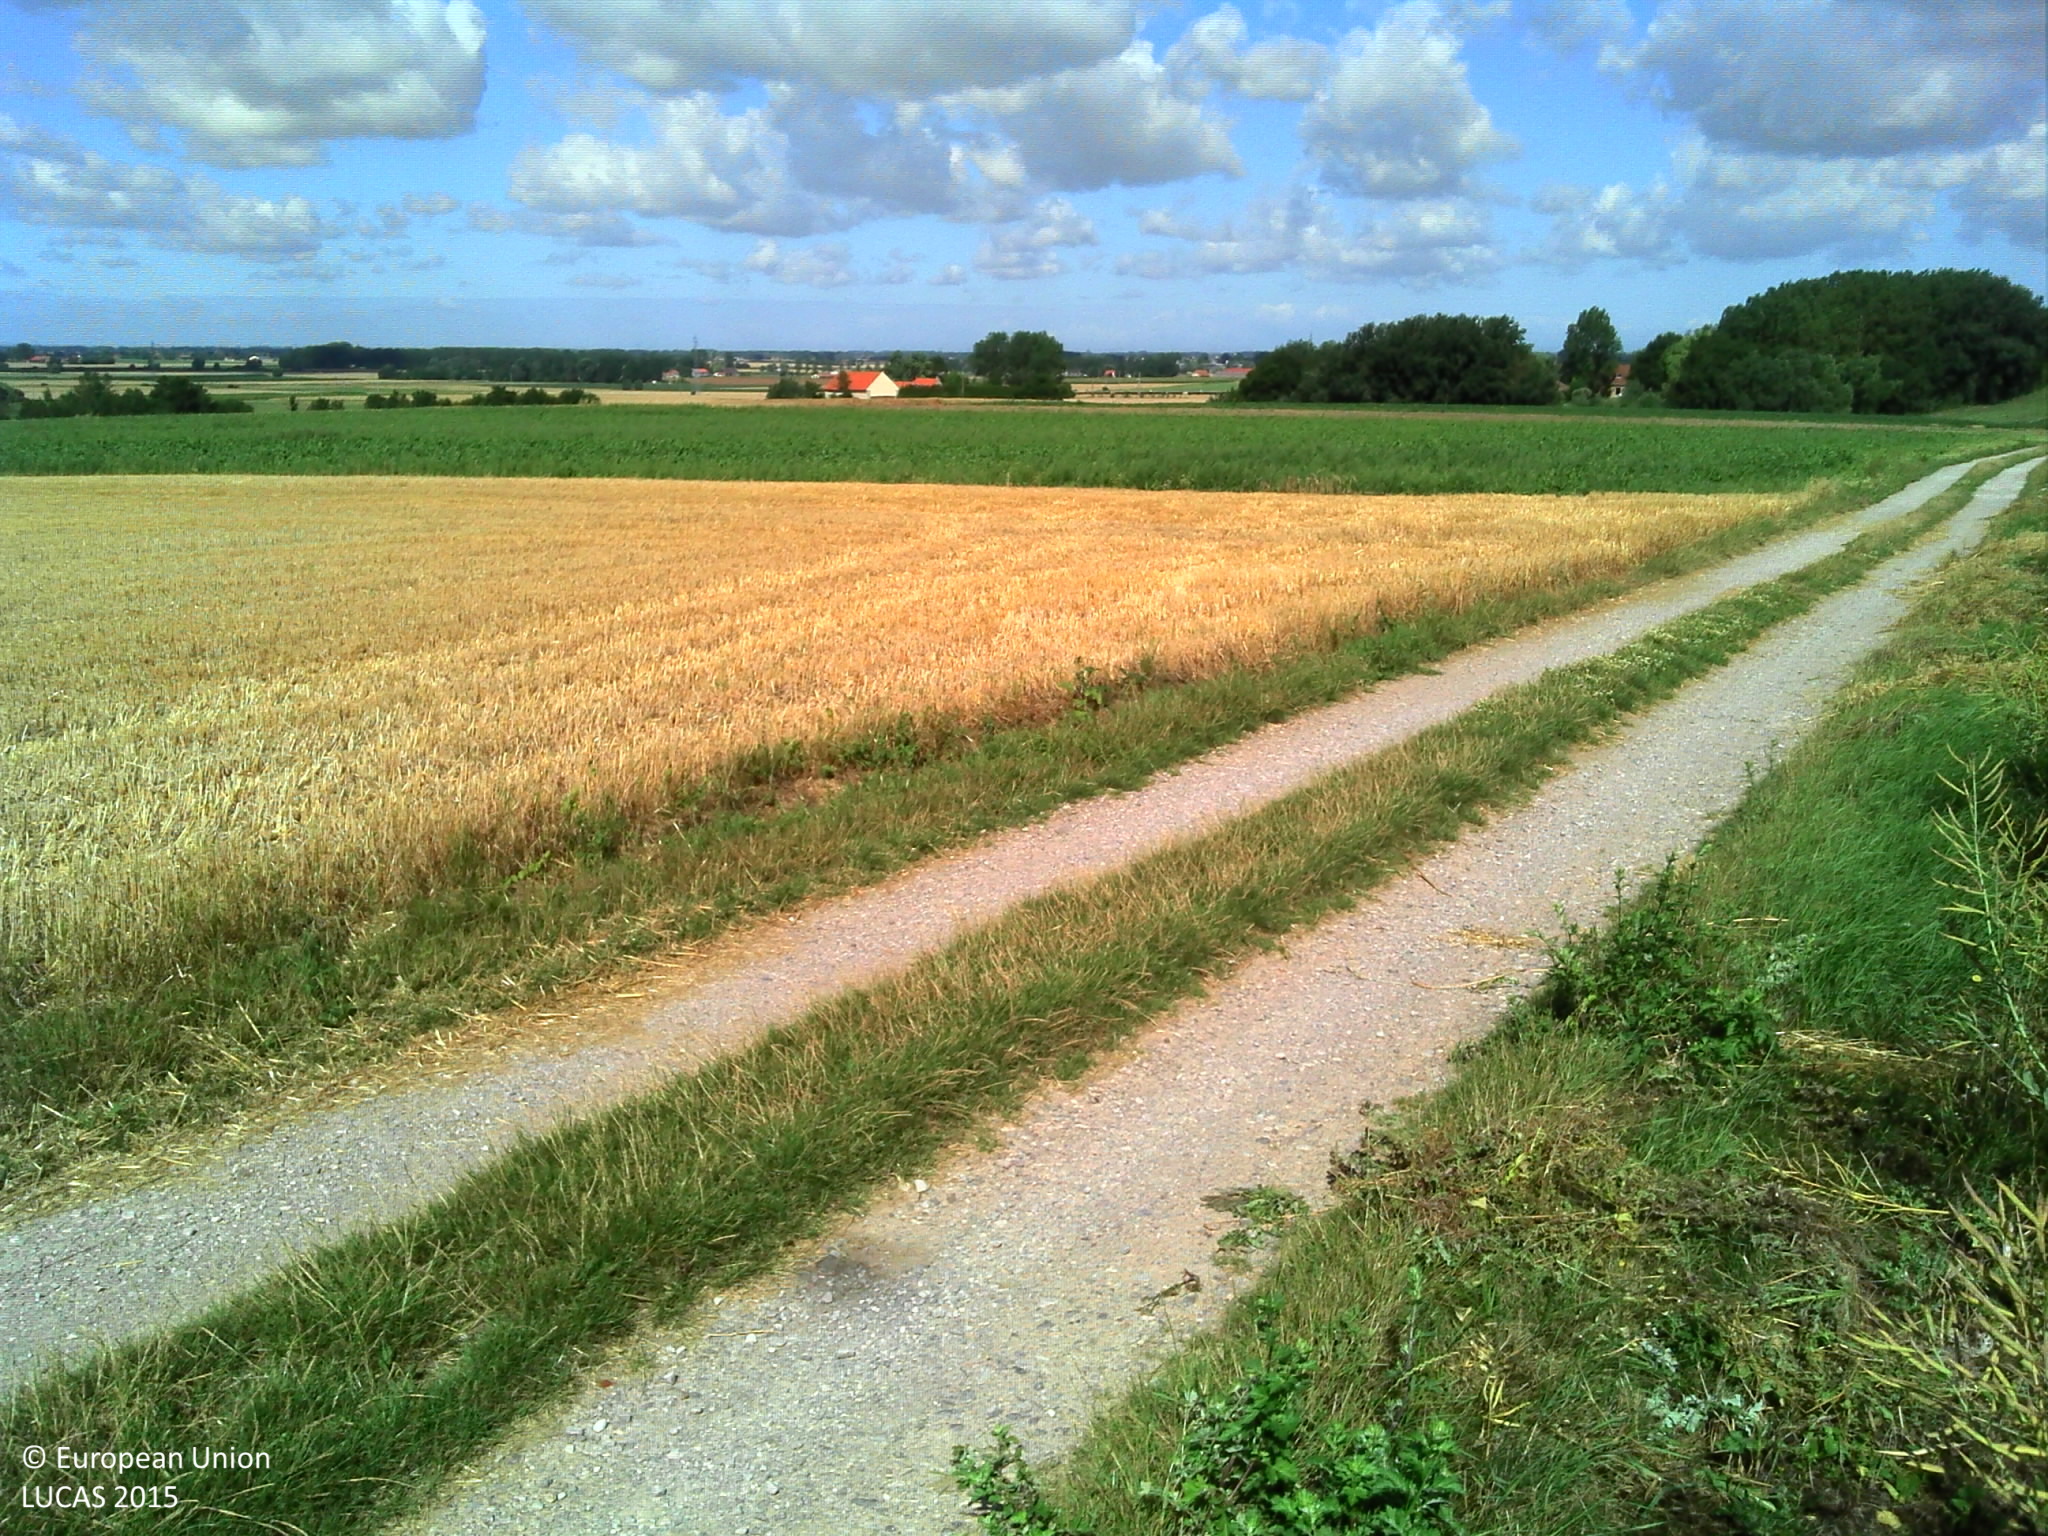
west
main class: Cropland
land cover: Rape and turnip rape
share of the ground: > 75 %
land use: Agriculture (excluding fallow land and kitchen gardens)
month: July
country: FR
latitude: 50.9203
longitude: 2.3473
